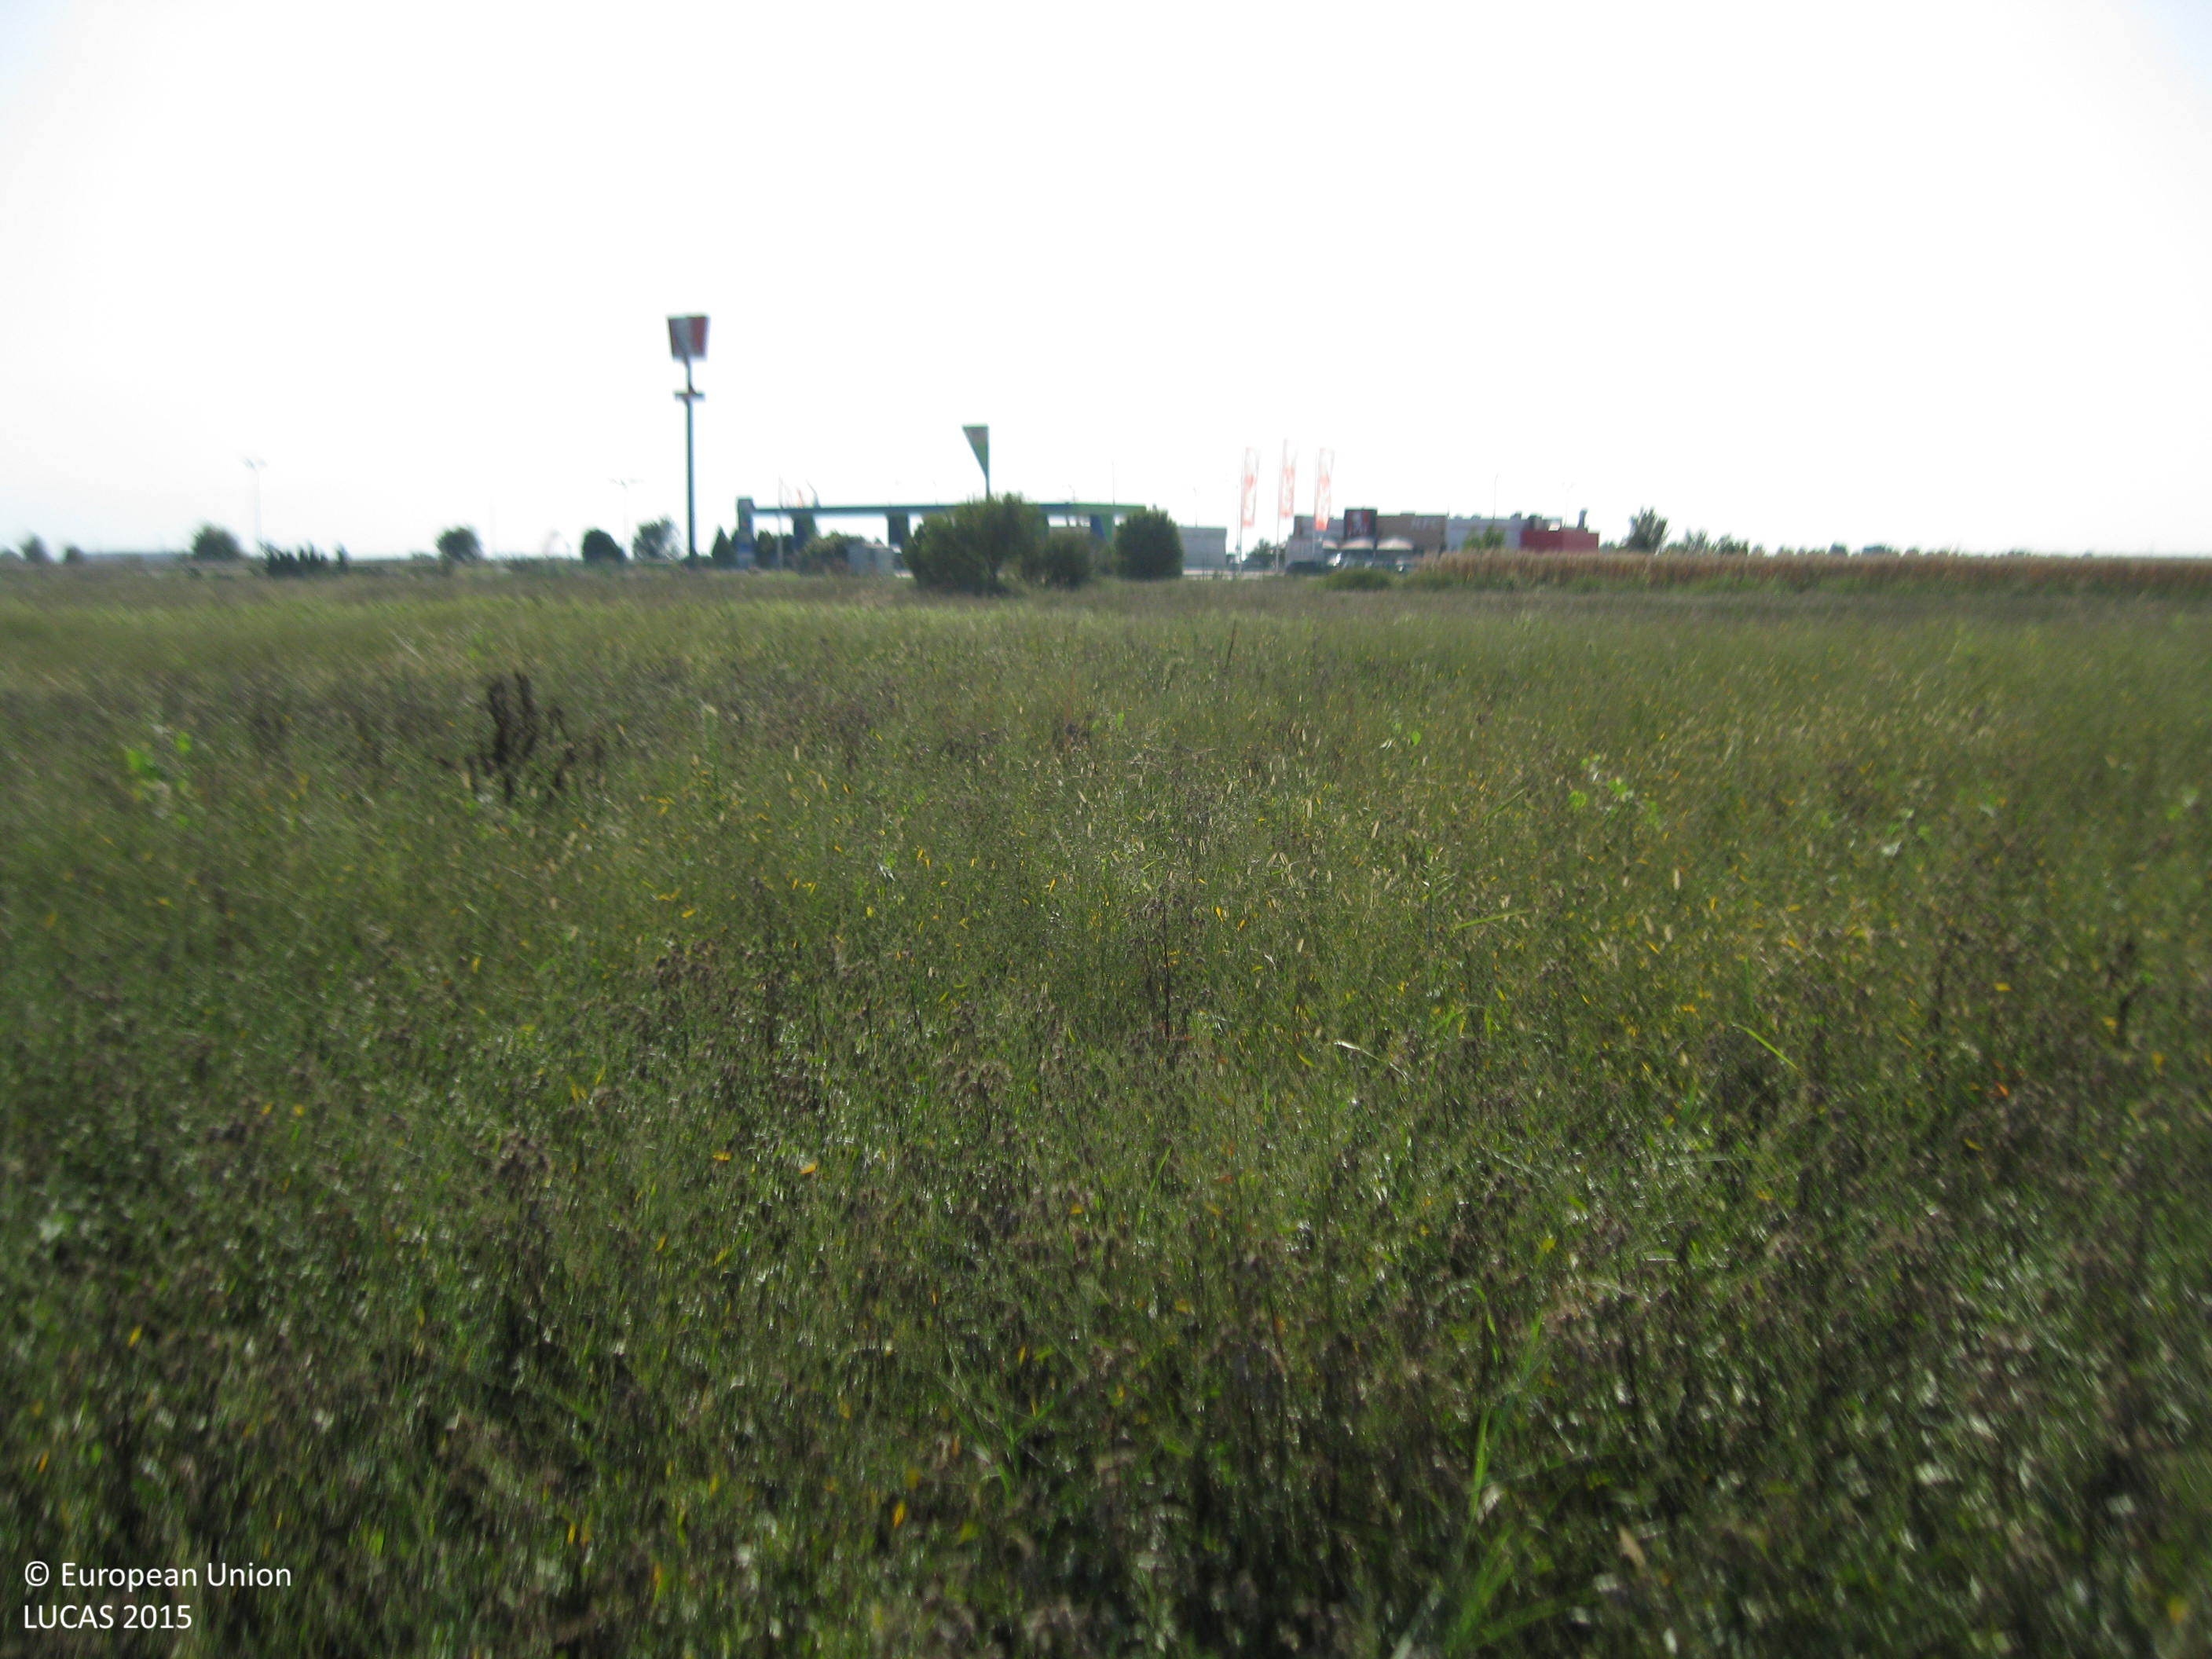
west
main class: Grassland
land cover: Spontaneously vegetated surfaces
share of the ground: > 75 %
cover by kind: herbaceous plants 100 %
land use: Fallow land
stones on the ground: < 10 %
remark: Harvested field
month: September
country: BG
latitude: 42.2199
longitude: 25.0435
